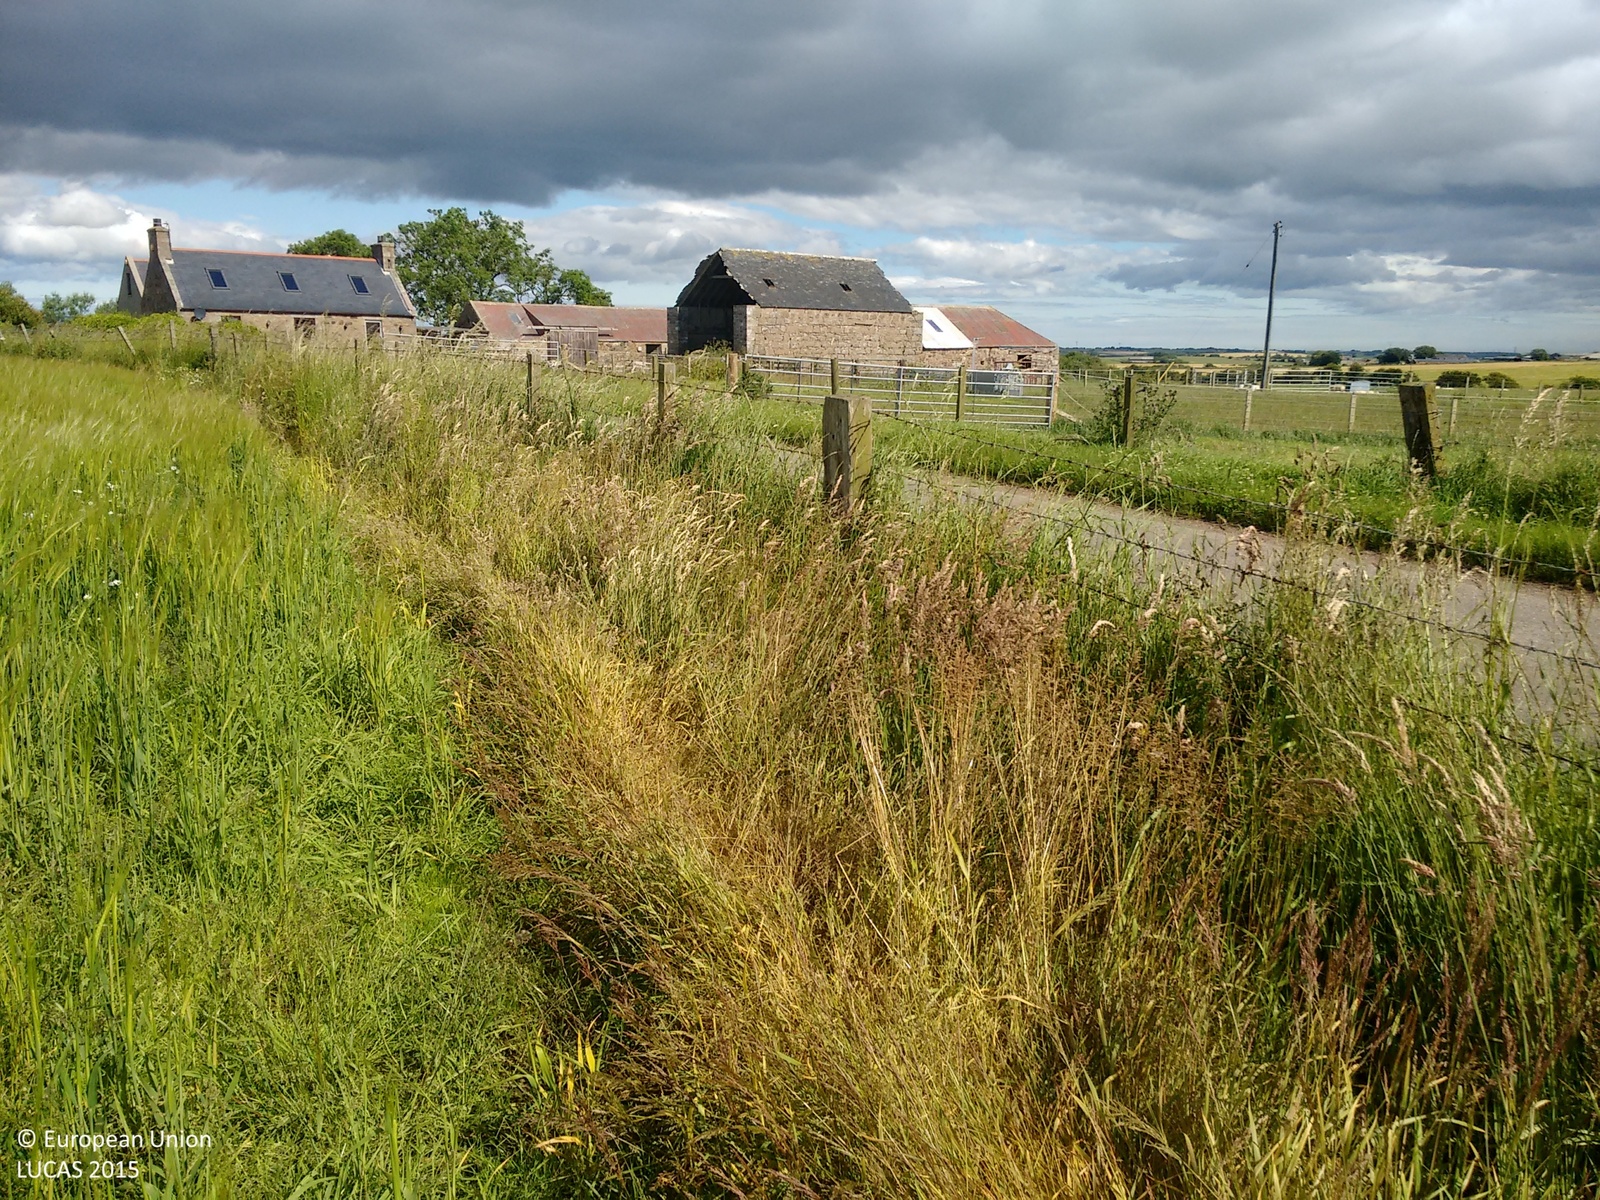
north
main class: Cropland
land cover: Barley
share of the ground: > 75 %
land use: Agriculture (excluding fallow land and kitchen gardens)
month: July
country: GB
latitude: 57.4849
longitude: -1.9373
